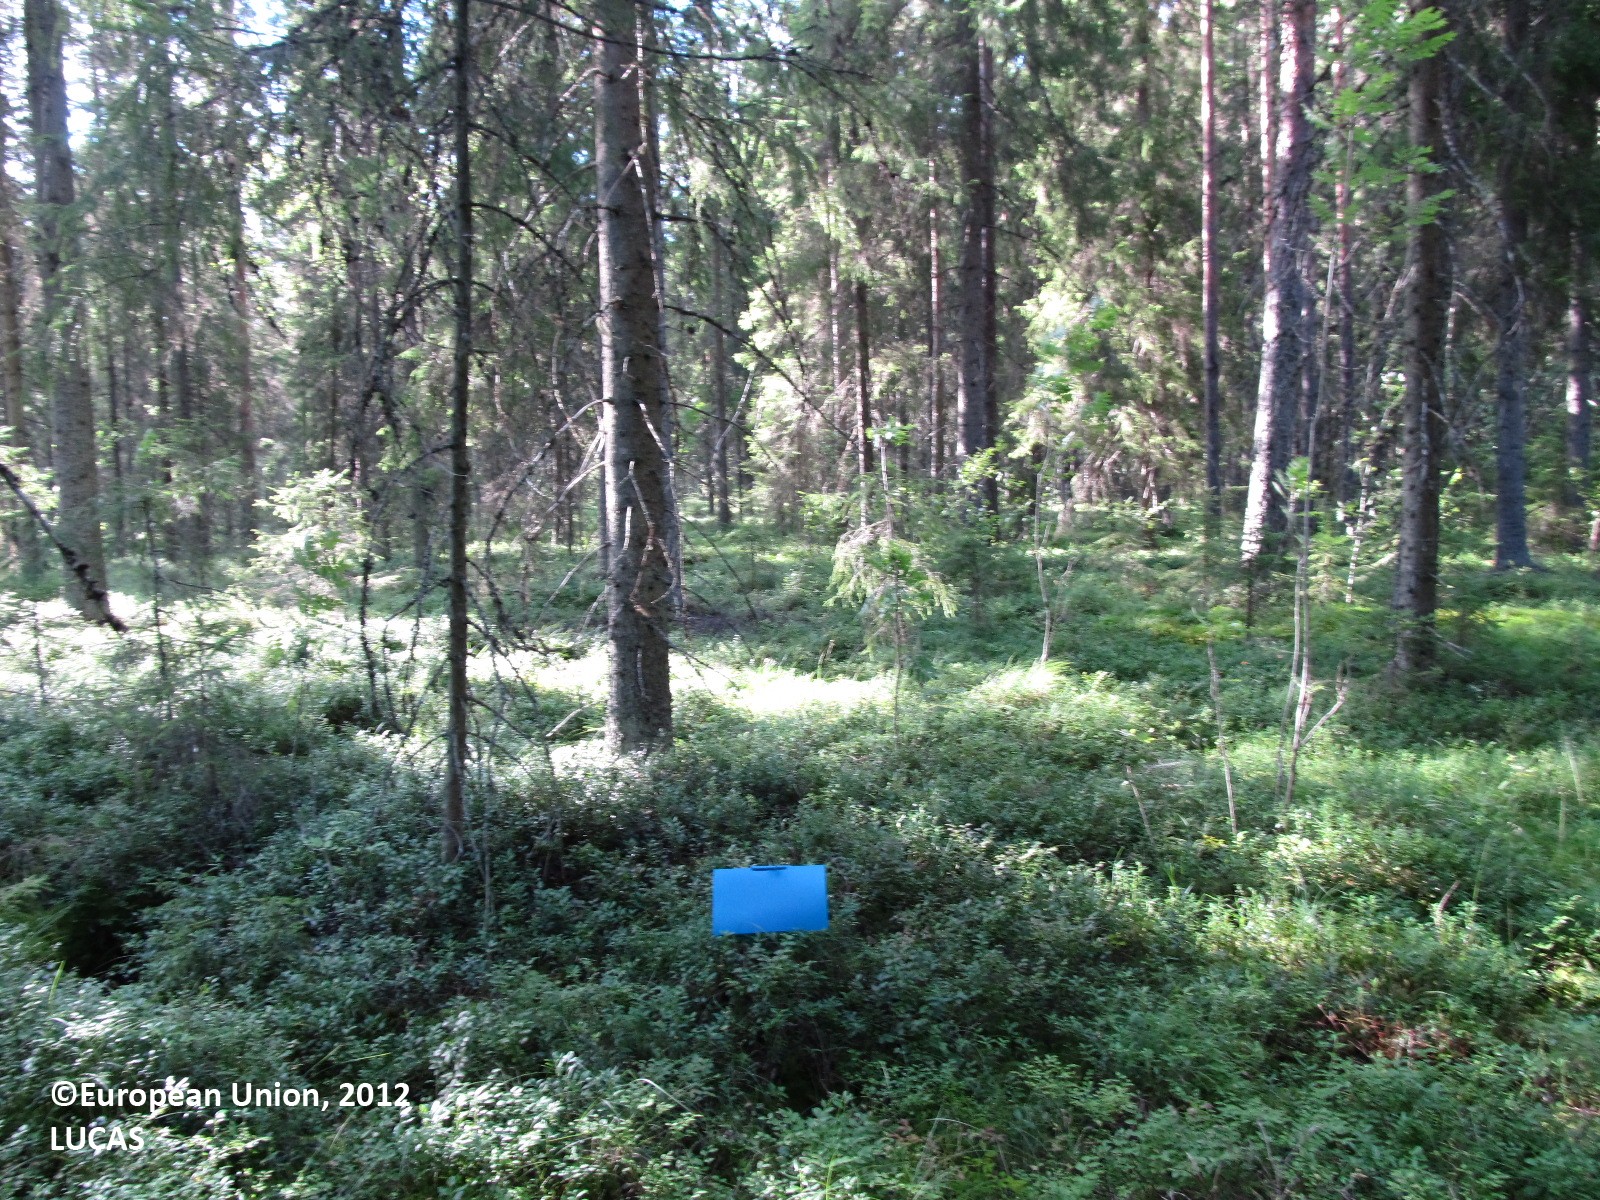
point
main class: Woodland
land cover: Spruce dominated coniferous woodland
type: boreal forest
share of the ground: 25 - 50 %
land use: Forestry
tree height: > 5 m
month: August
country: FI
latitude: 61.8661
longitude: 27.8460
